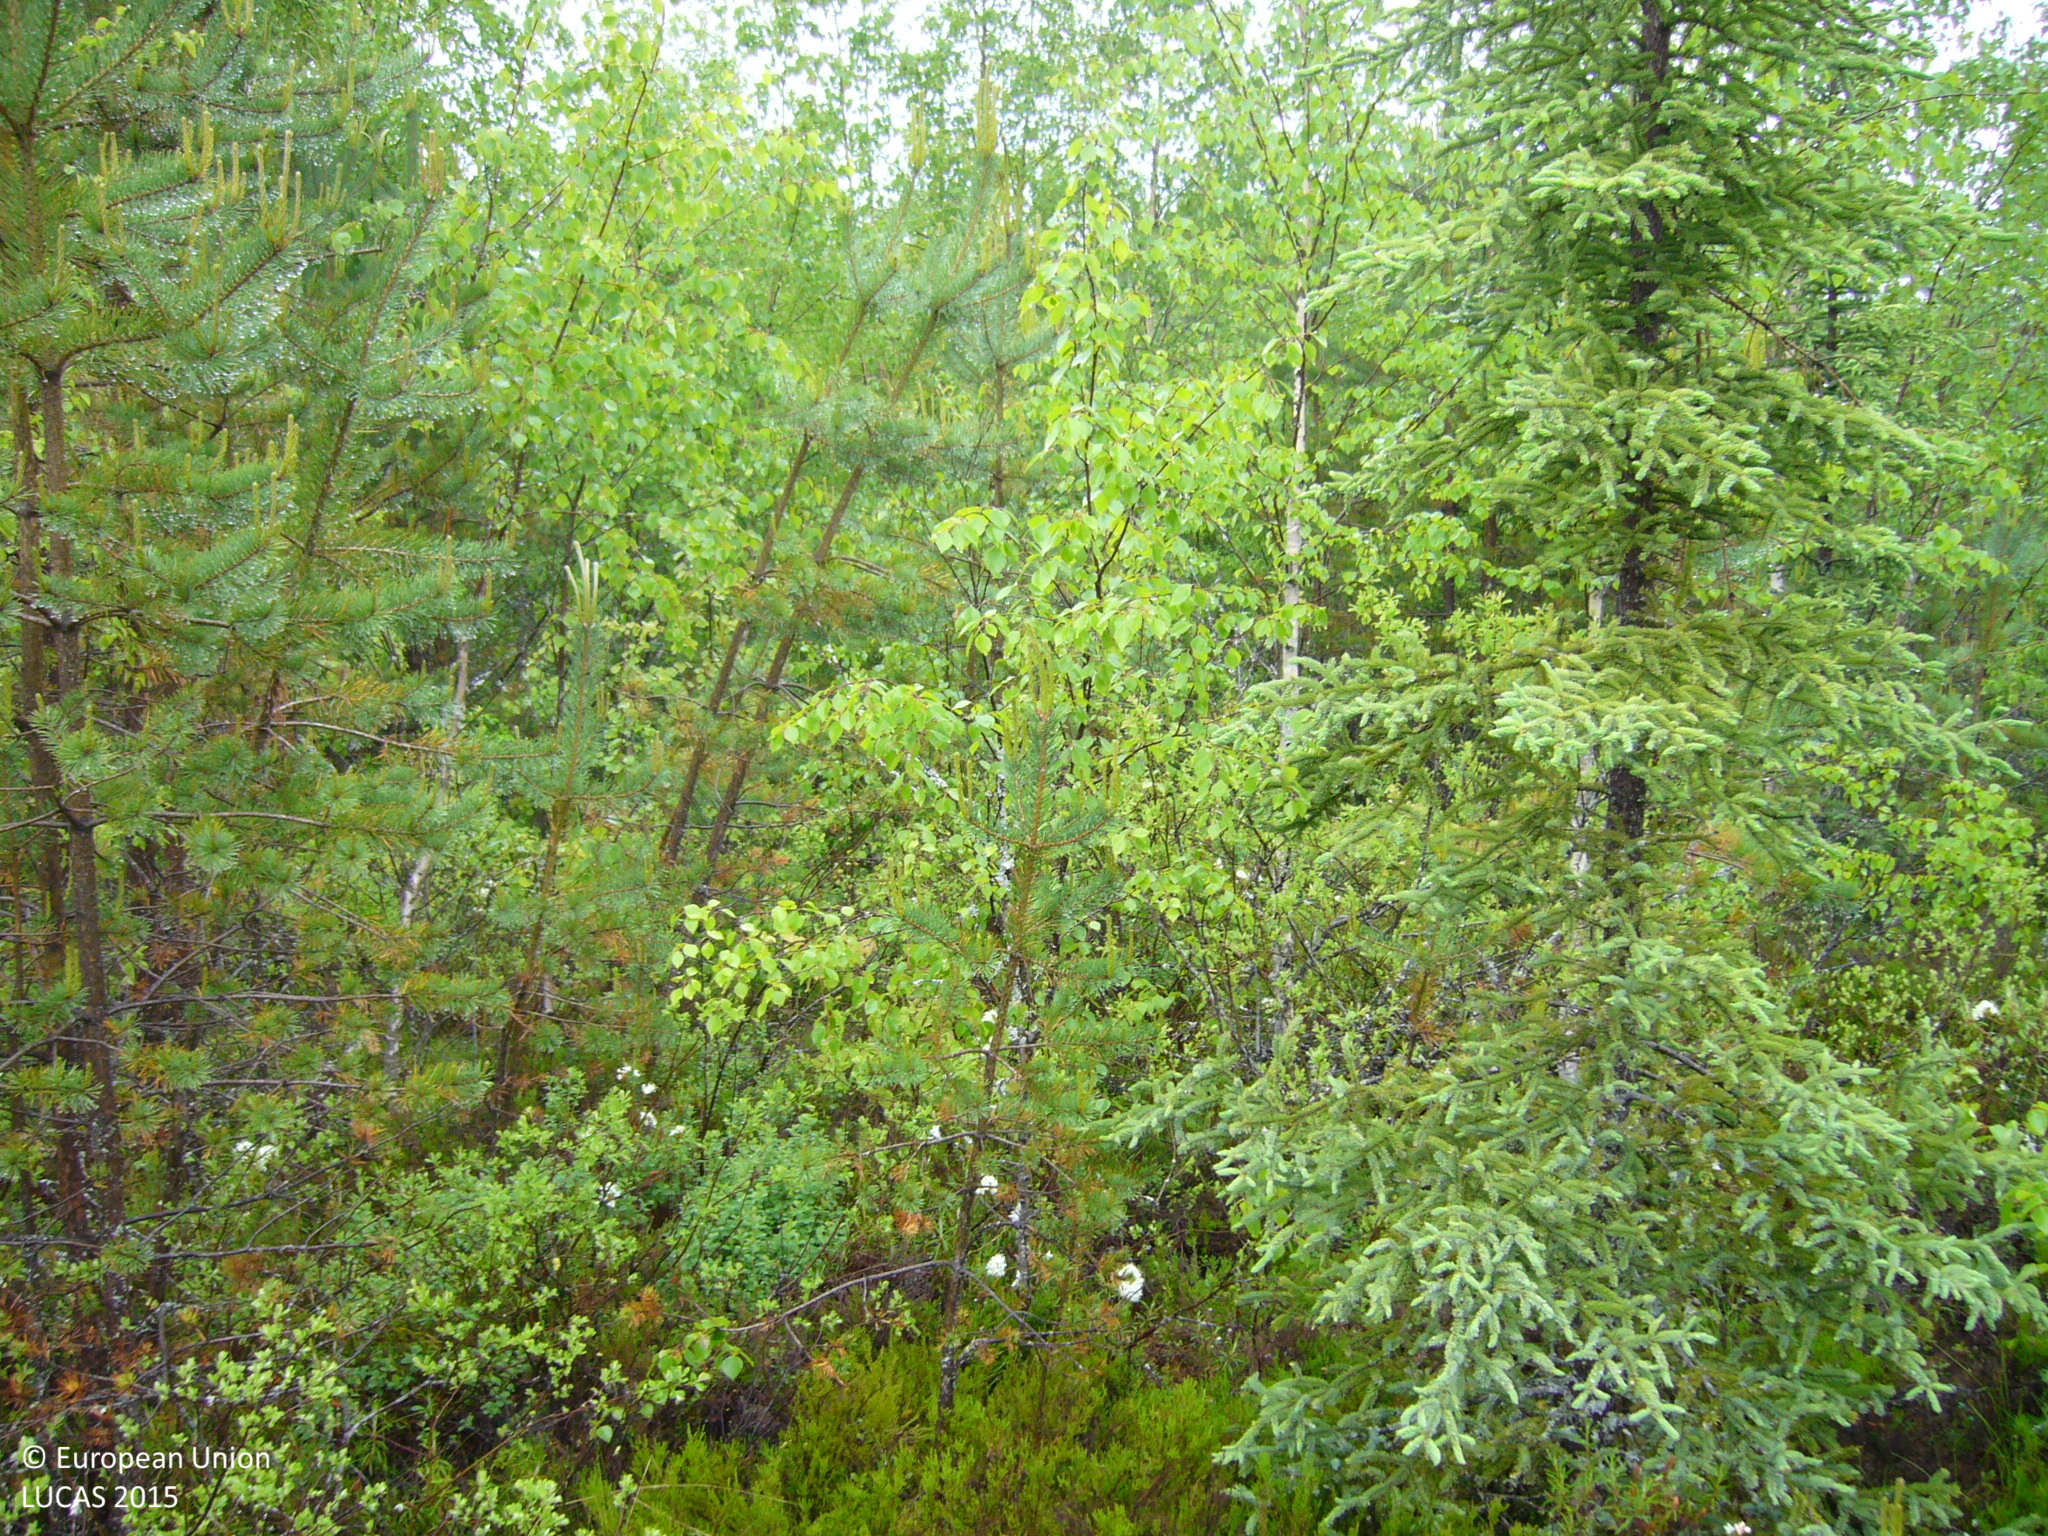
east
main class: Woodland
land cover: Pine dominated mixed woodland
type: boreal forest
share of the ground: 50 - 75 %
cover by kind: shrubs 45 %, coniferous forest trees 30 %, broadleaved forest trees 25 %
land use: Forestry
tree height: < 5 m
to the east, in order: Pine dominated mixed woodland; Other mixed woodland; Ditches and canals; Other mixed woodland; Shrubland with sparse tree cover; Pine dominated mixed woodland; Ditches and canals; Conifer hedges; Shruby margins; Paved roads, cycling and walking lanes; Shruby margins; Ditches and canals; Pine dominated mixed woodland
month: June
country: FI
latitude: 63.8112
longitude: 24.9728
